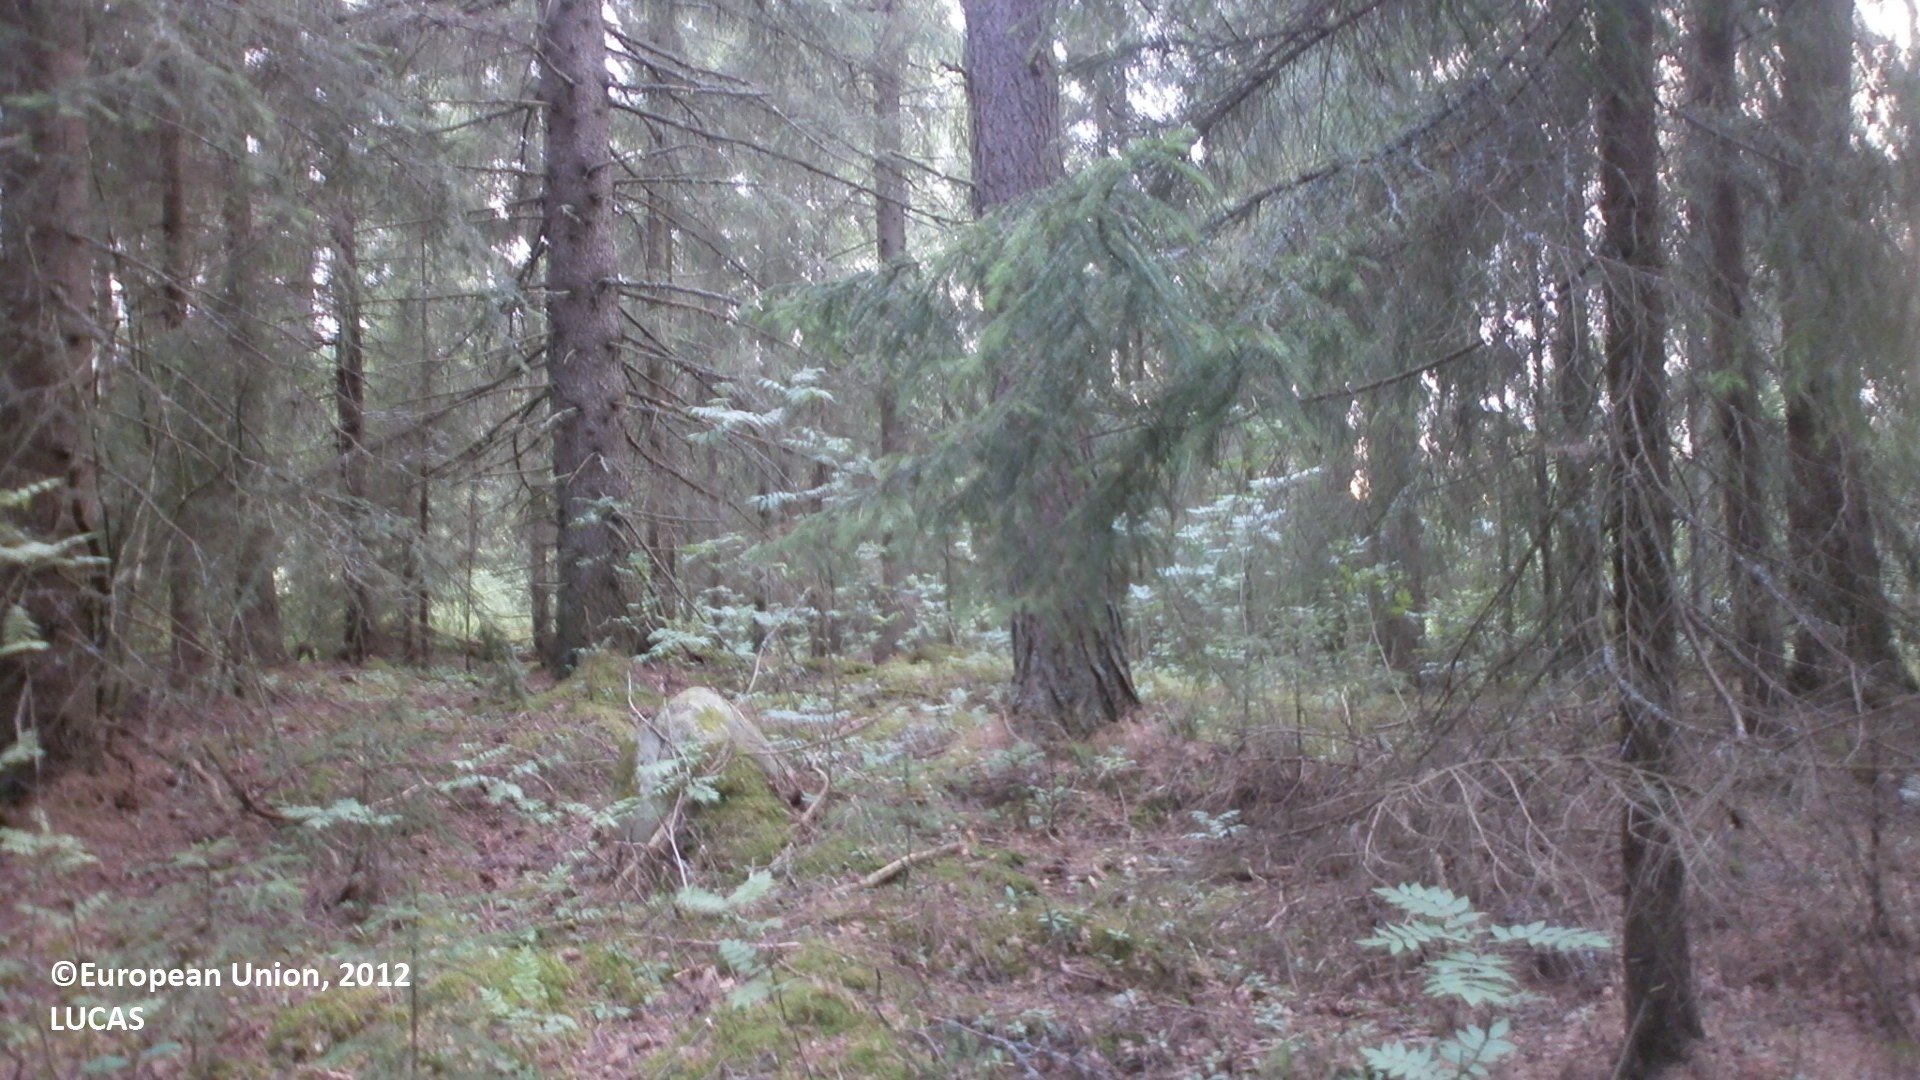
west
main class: Woodland
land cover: Spruce dominated mixed woodland
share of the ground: > 75 %
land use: Forestry
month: July
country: FI
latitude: 64.3046
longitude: 24.4365
